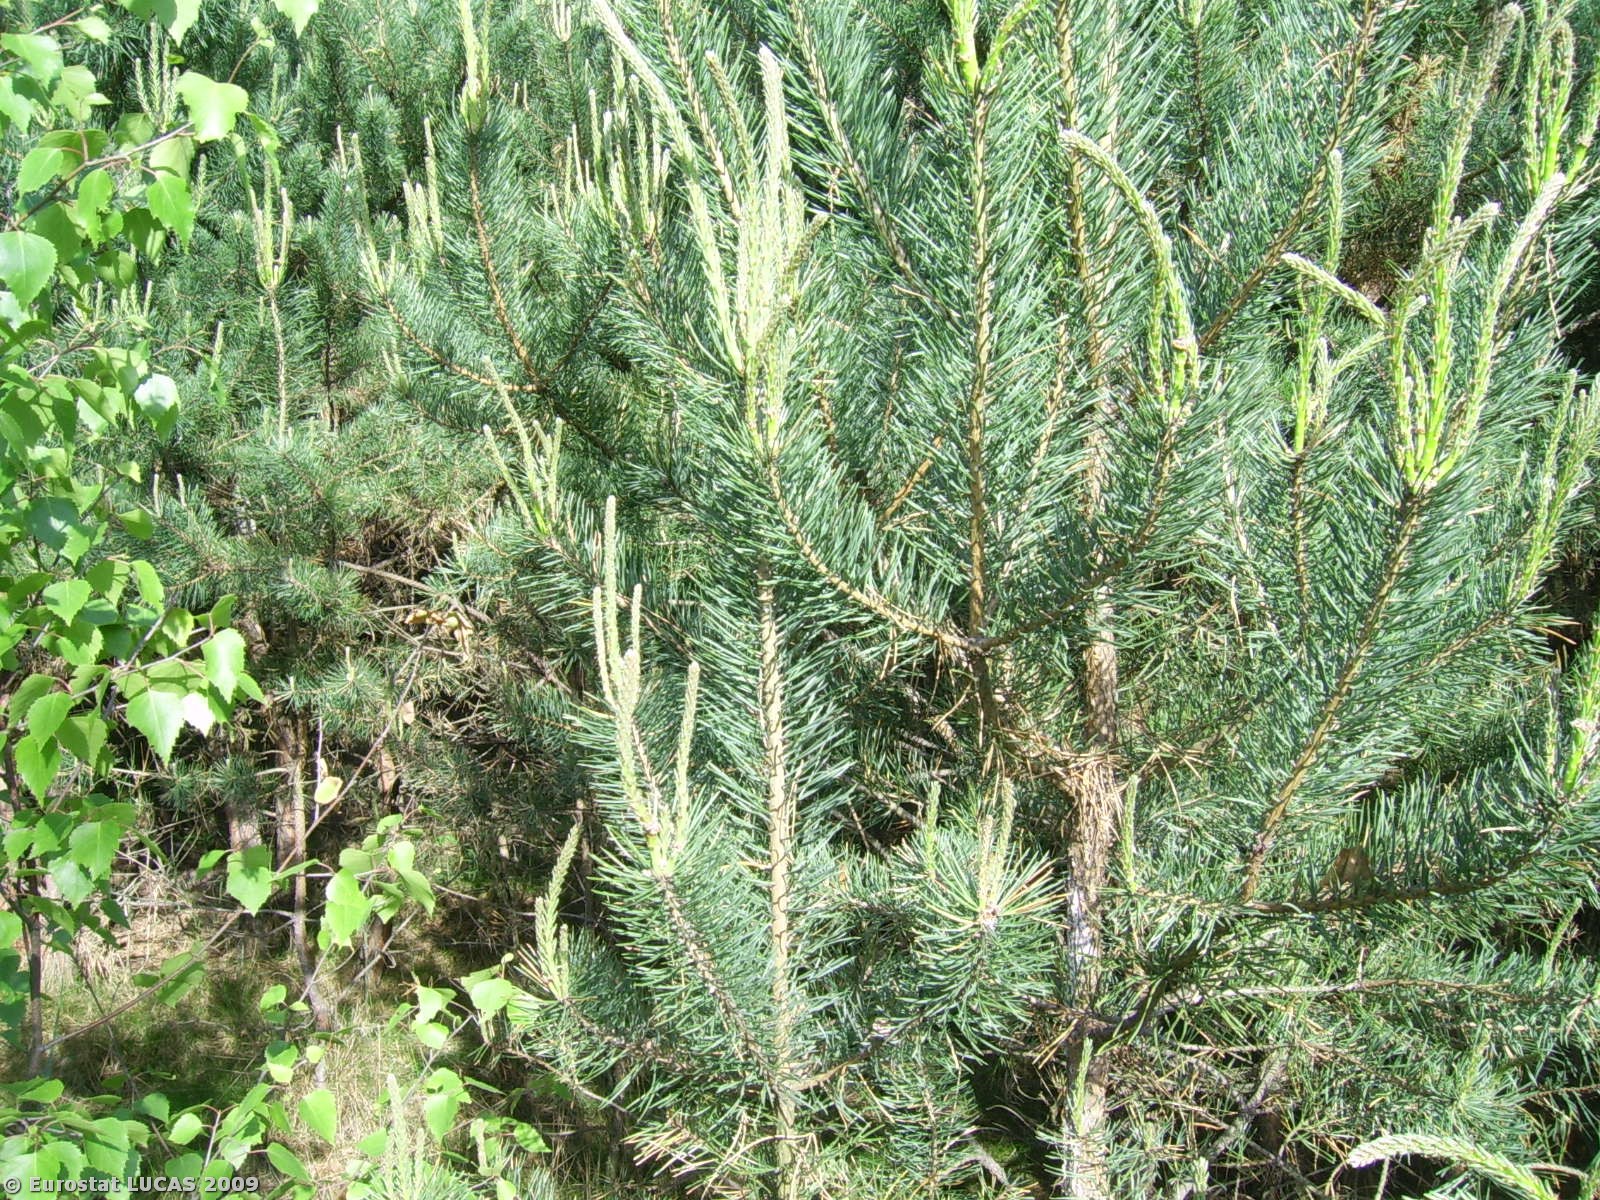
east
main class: Woodland
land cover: Mixed woodland
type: hemiboreal forest and nemoral coniferous forest and mixed broadleaved-coniferous forest
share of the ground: > 75 %
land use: Forestry
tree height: > 5 m
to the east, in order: Mixed woodland; Paved roads, cycling and walking lanes; Coniferous woodland
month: May
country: PL
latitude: 52.9795
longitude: 18.1931
